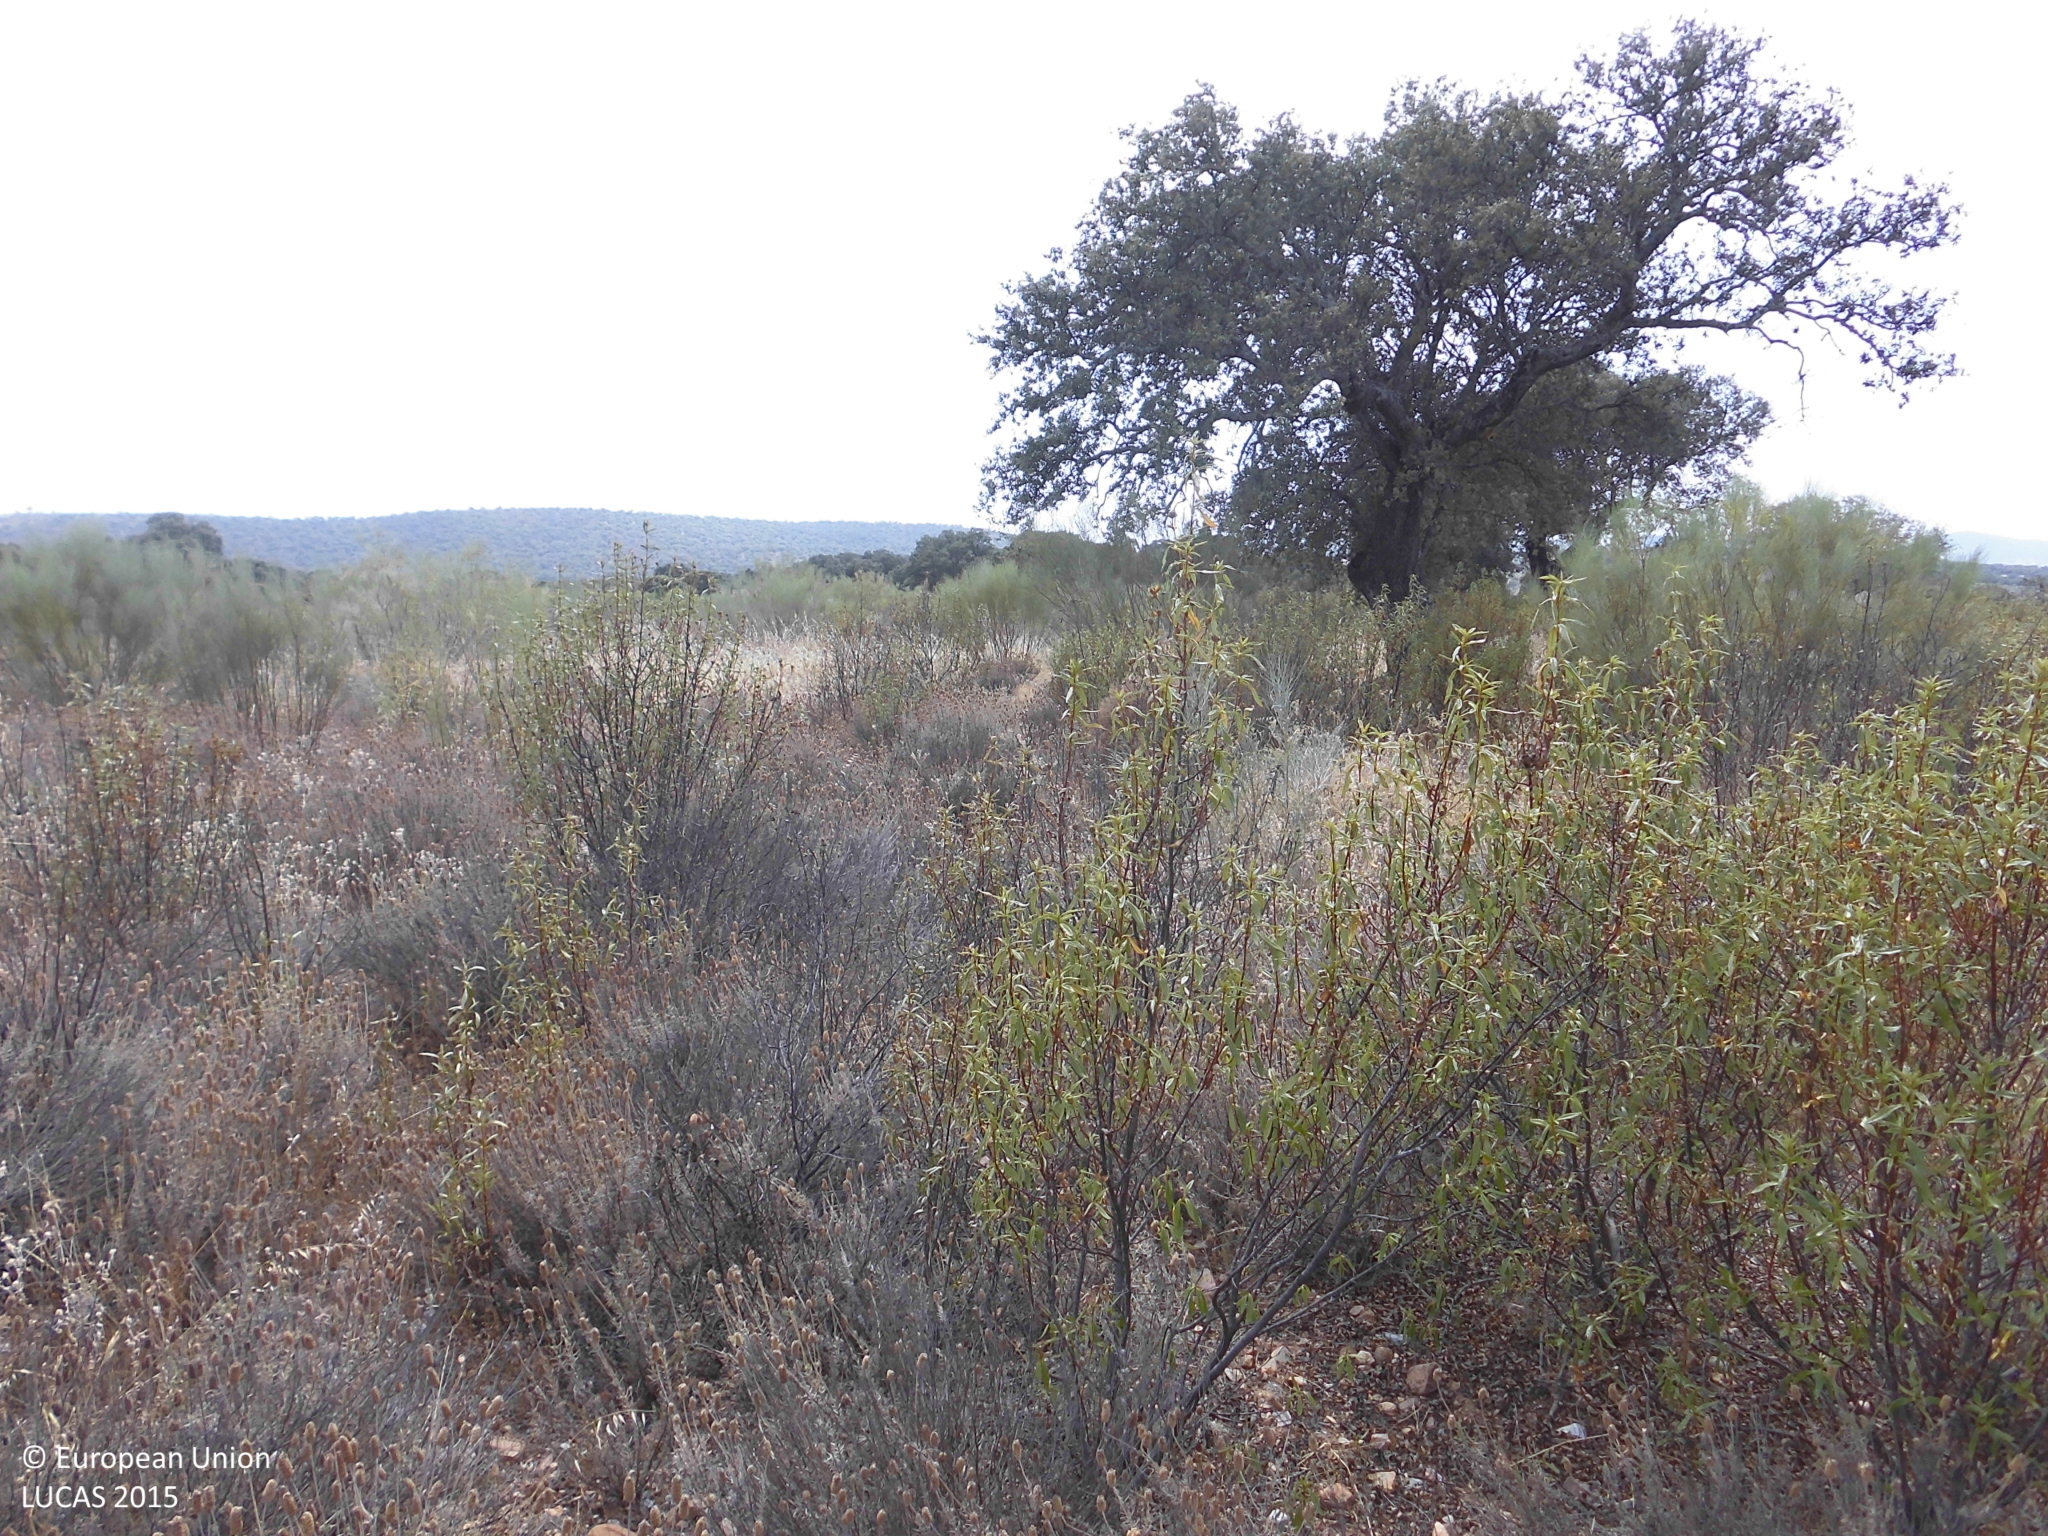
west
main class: Shrubland
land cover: Shrubland with sparse tree cover
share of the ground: 10 - 25 %
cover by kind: herbaceous plants 75 %, shrubs 20 %, broadleaved forest trees 5 %
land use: Agriculture (excluding fallow land and kitchen gardens)
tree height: > 5 m
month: July
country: ES
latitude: 39.8229
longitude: -6.4673
